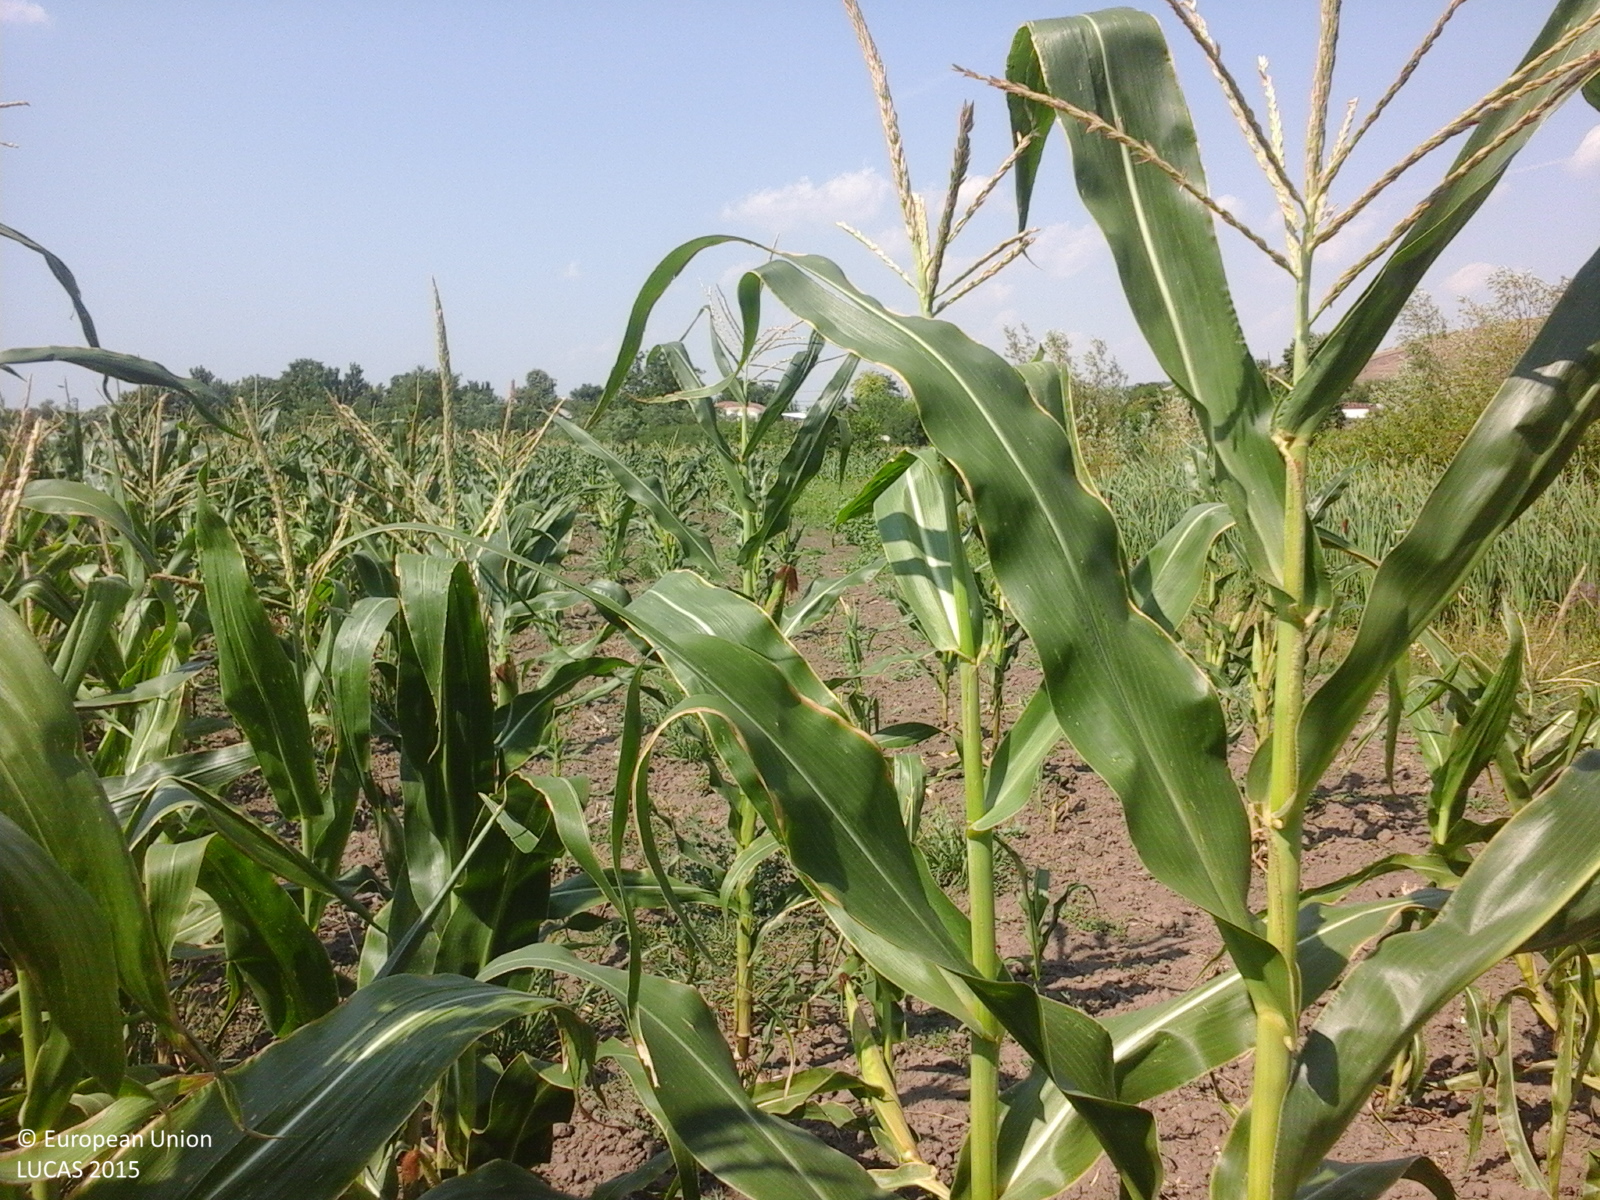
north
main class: Cropland
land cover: Maize
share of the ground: > 75 %
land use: Agriculture (excluding fallow land and kitchen gardens)
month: July
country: RO
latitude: 46.0031
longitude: 27.4741
